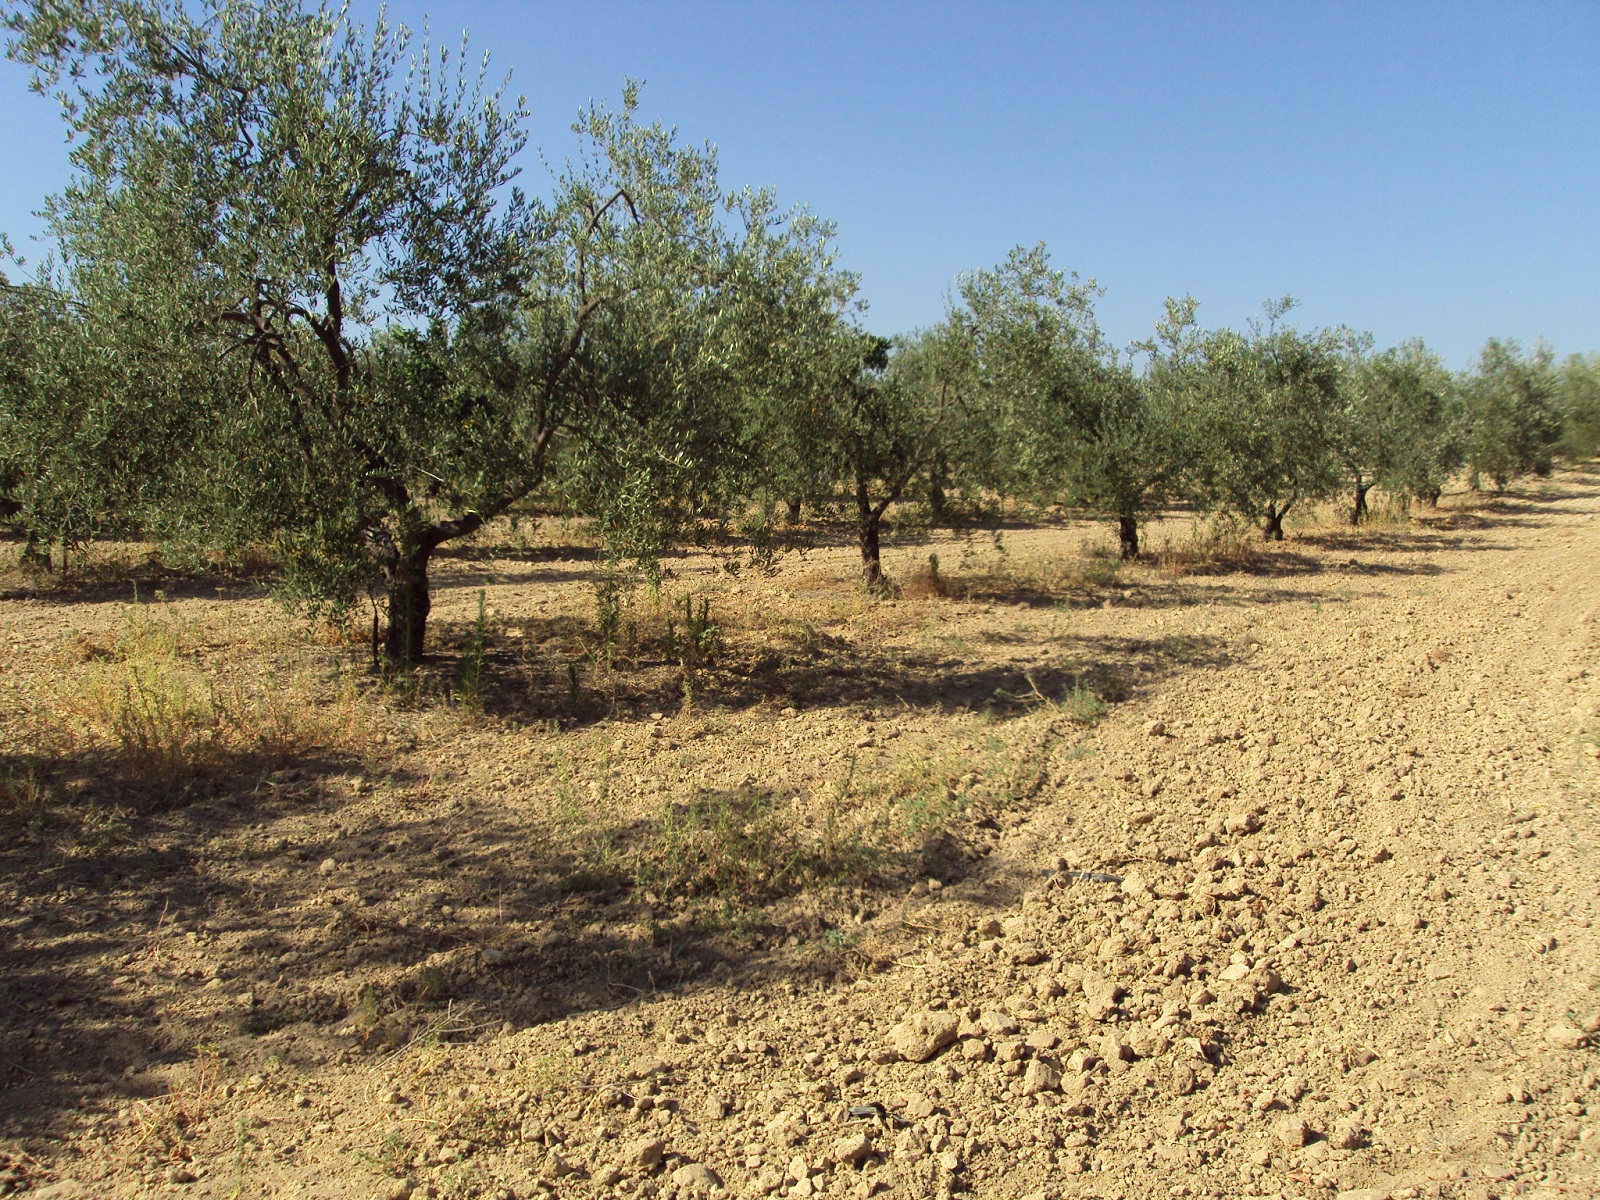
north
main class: Cropland
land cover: Olive groves
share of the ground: 25 - 50 %
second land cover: Spontaneously vegetated surfaces
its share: > 75 %
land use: Agriculture (excluding fallow land and kitchen gardens)
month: June
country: ES
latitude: 37.3277
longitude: -6.6119
